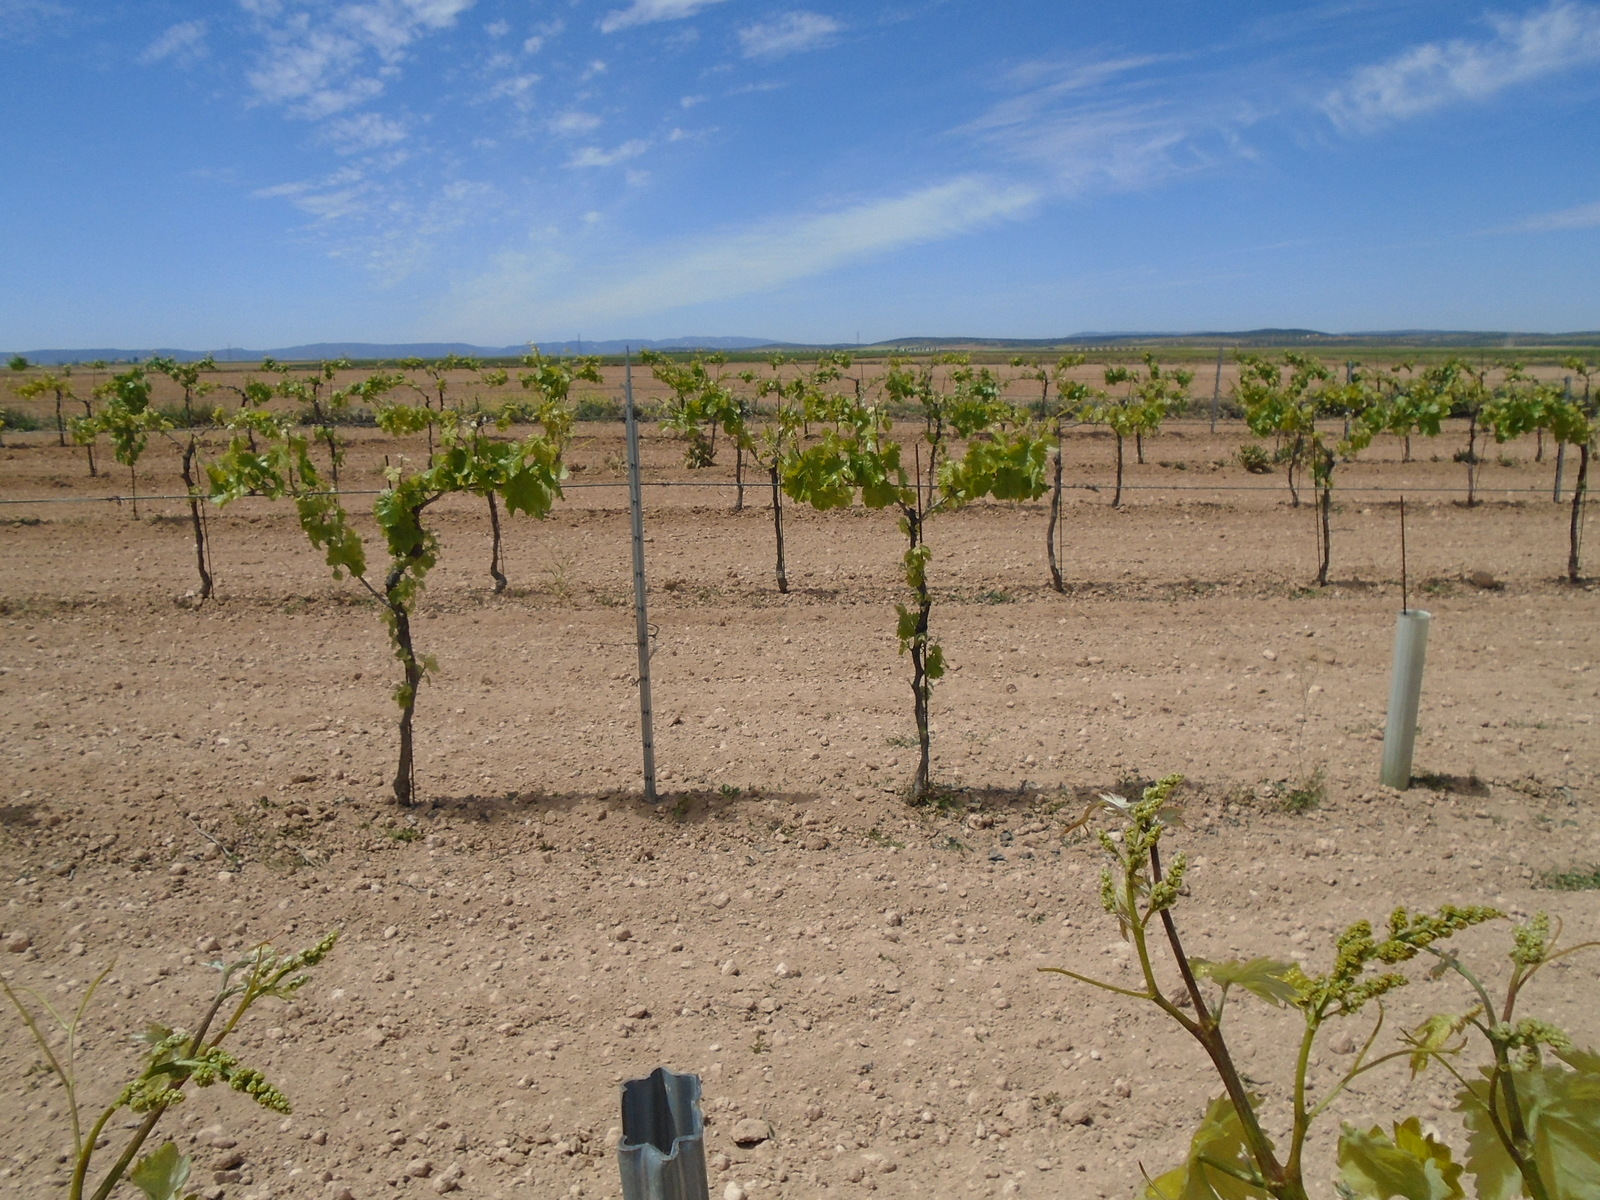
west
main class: Cropland
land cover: Vineyards
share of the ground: 10 - 25 %
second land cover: Other bare soil
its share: > 75 %
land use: Agriculture (excluding fallow land and kitchen gardens)
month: May
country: ES
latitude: 39.5819
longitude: -3.6592
